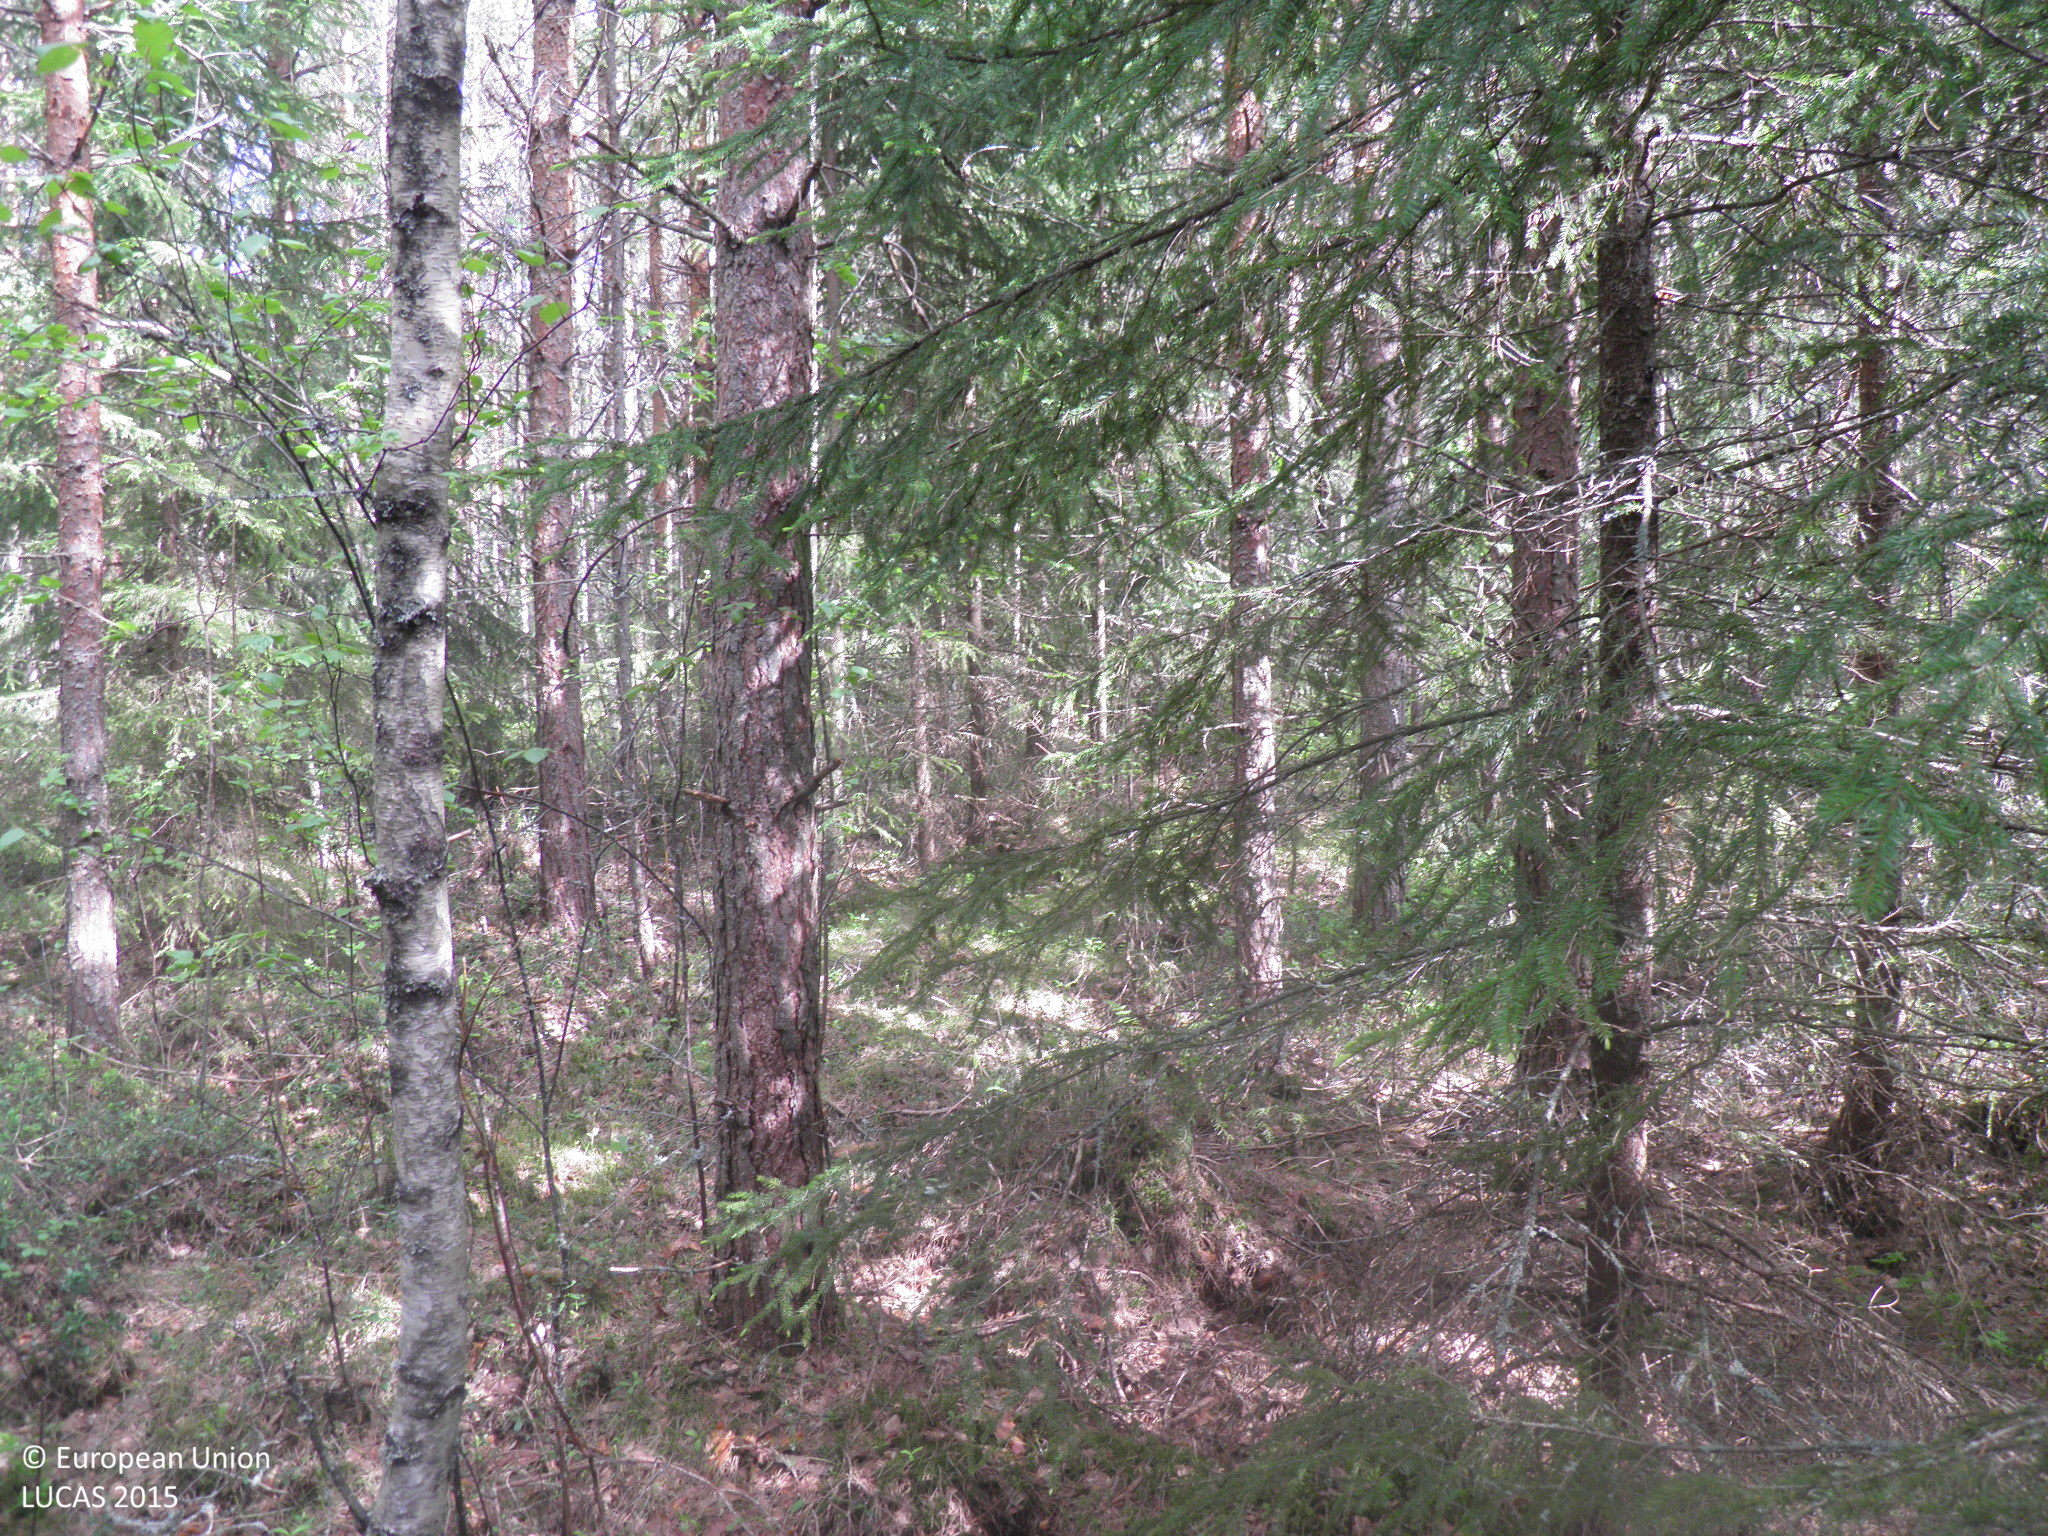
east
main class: Woodland
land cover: Other coniferous woodland
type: boreal forest
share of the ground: > 75 %
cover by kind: coniferous forest trees 70 %, broadleaved forest trees 20 %, shrubs 5 %, lichens and mosses 5 %
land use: Forestry
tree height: > 5 m
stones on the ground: < 10 %
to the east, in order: Other coniferous woodland; Lichens and moss; Other coniferous woodland; Ponds and wetlands; Other coniferous woodland; Pine dominated coniferous woodland
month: June
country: FI
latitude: 60.5625
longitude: 22.6027
